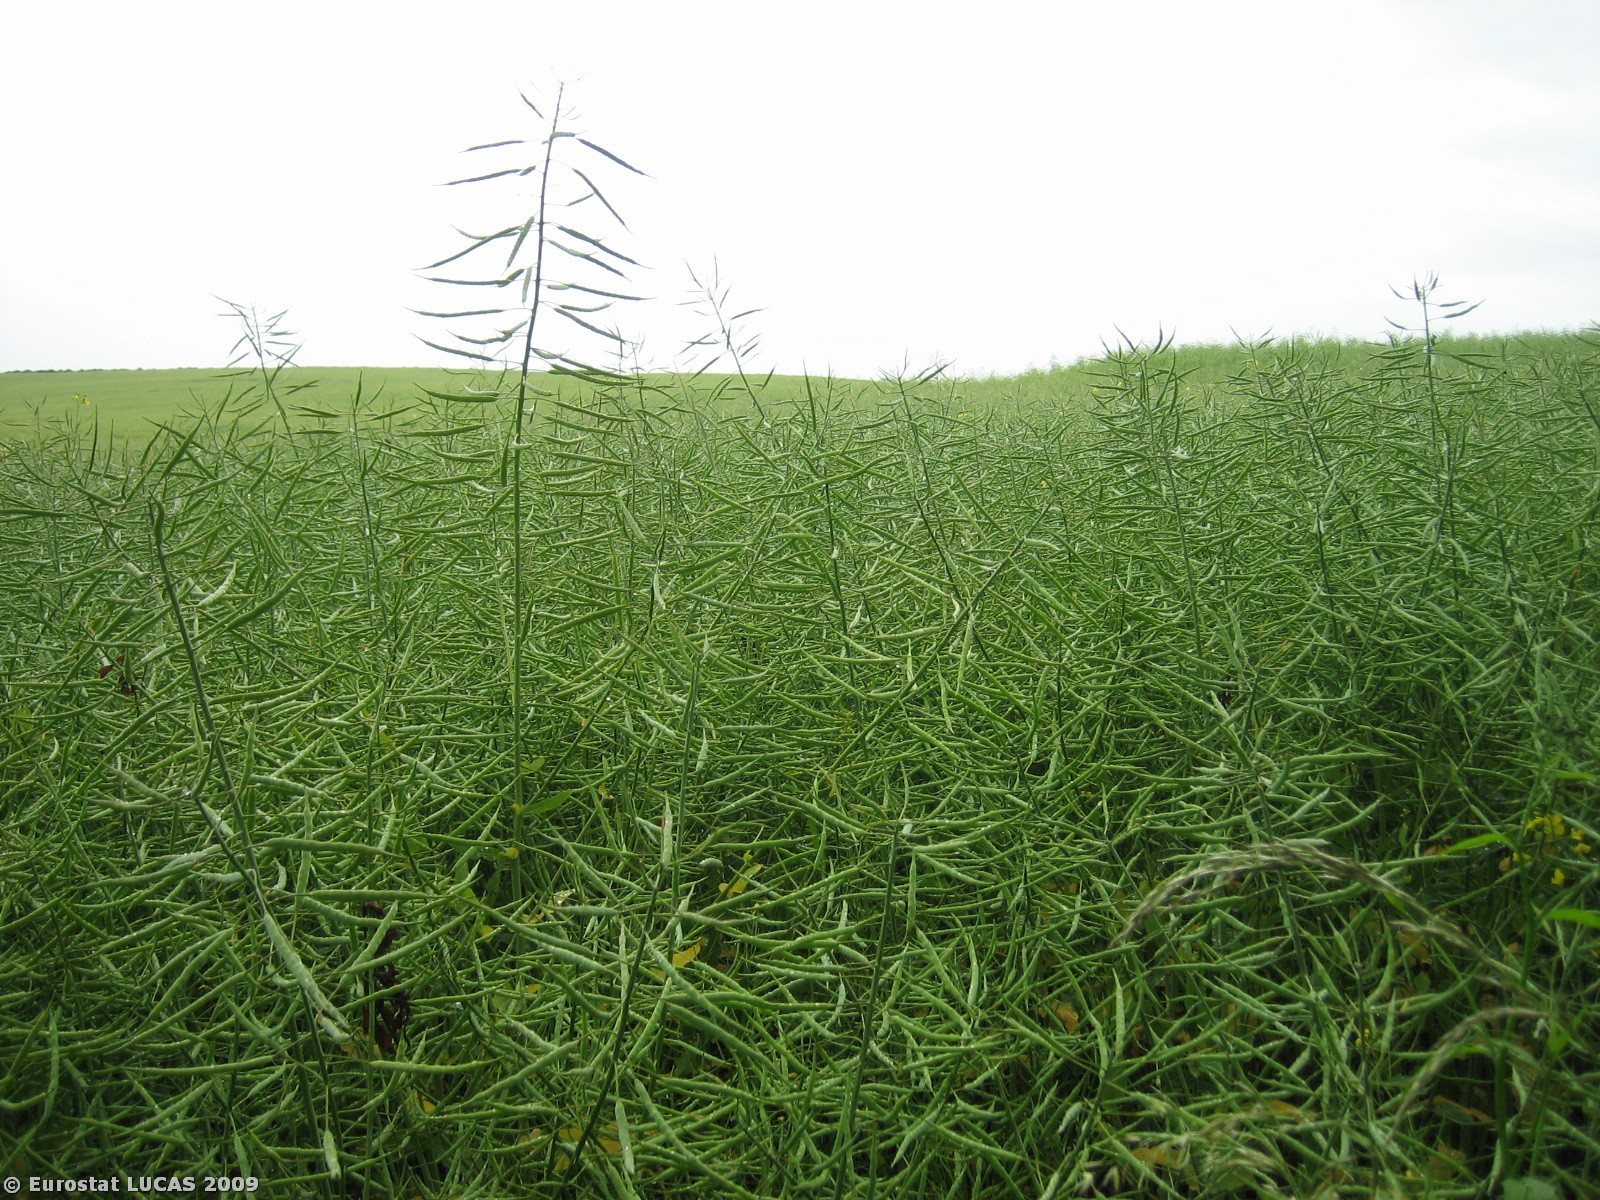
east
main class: Cropland
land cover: Rape and turnip rape
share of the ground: > 75 %
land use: Agriculture (excluding fallow land and kitchen gardens)
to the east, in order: Rape and turnip rape
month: June
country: DK
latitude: 55.9181
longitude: 10.1119
